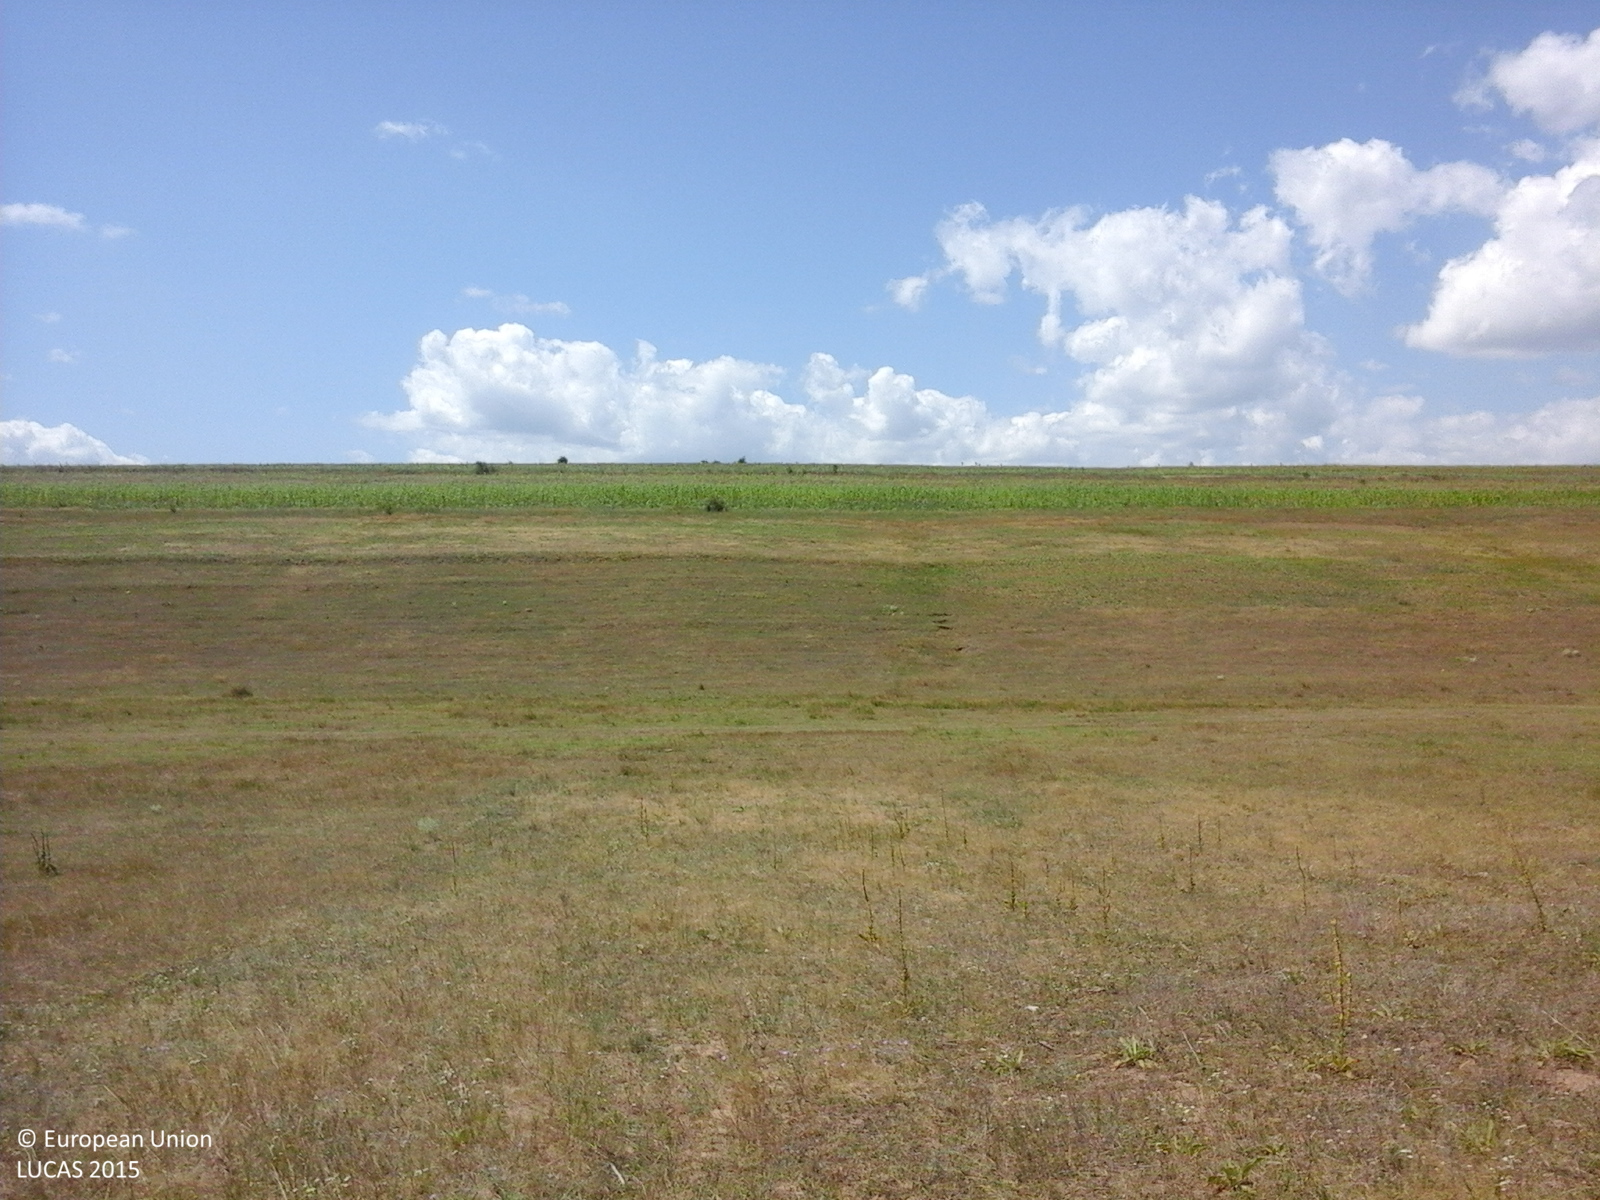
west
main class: Grassland
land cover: Grassland without tree/shrub cover
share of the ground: > 75 %
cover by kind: herbaceous plants 100 %
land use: Agriculture (excluding fallow land and kitchen gardens)
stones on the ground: < 10 %
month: July
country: RO
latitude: 46.1961
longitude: 27.8593
